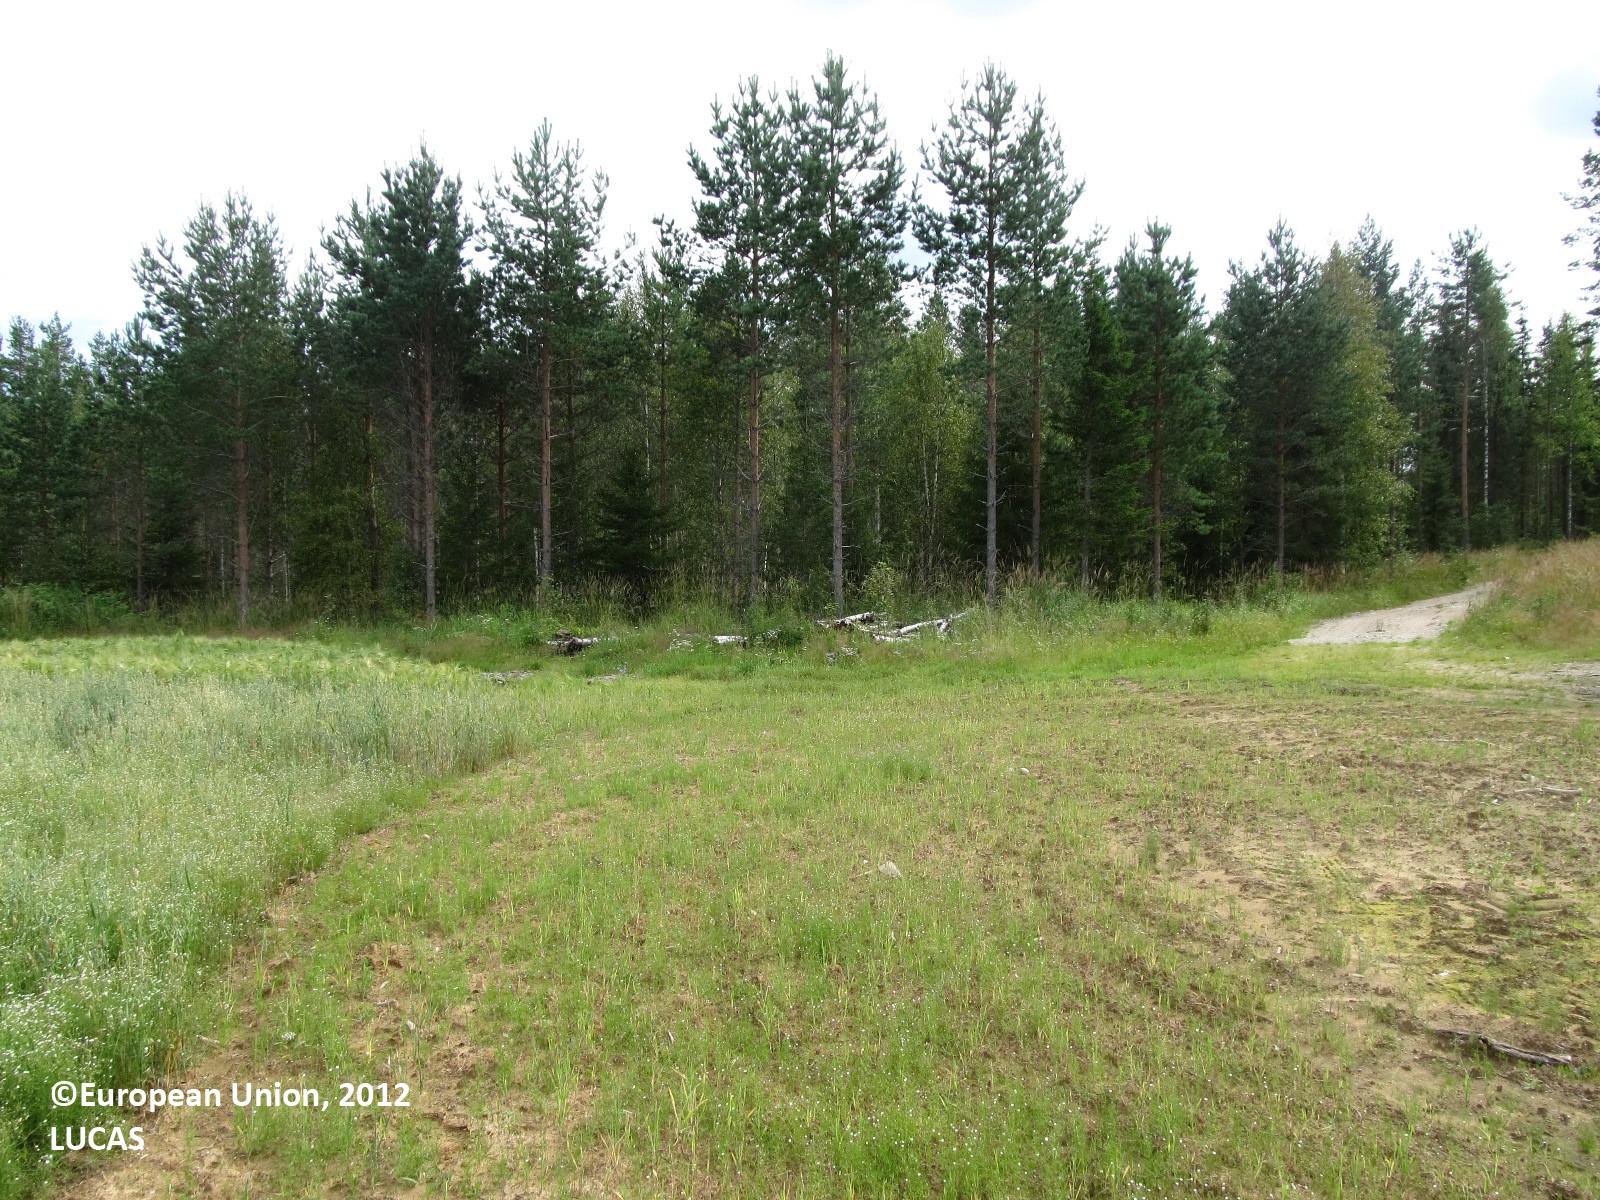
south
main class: Cropland
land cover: Oats
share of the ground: > 75 %
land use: Agriculture (excluding fallow land and kitchen gardens)
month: August
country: FI
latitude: 62.3346
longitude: 28.5652
